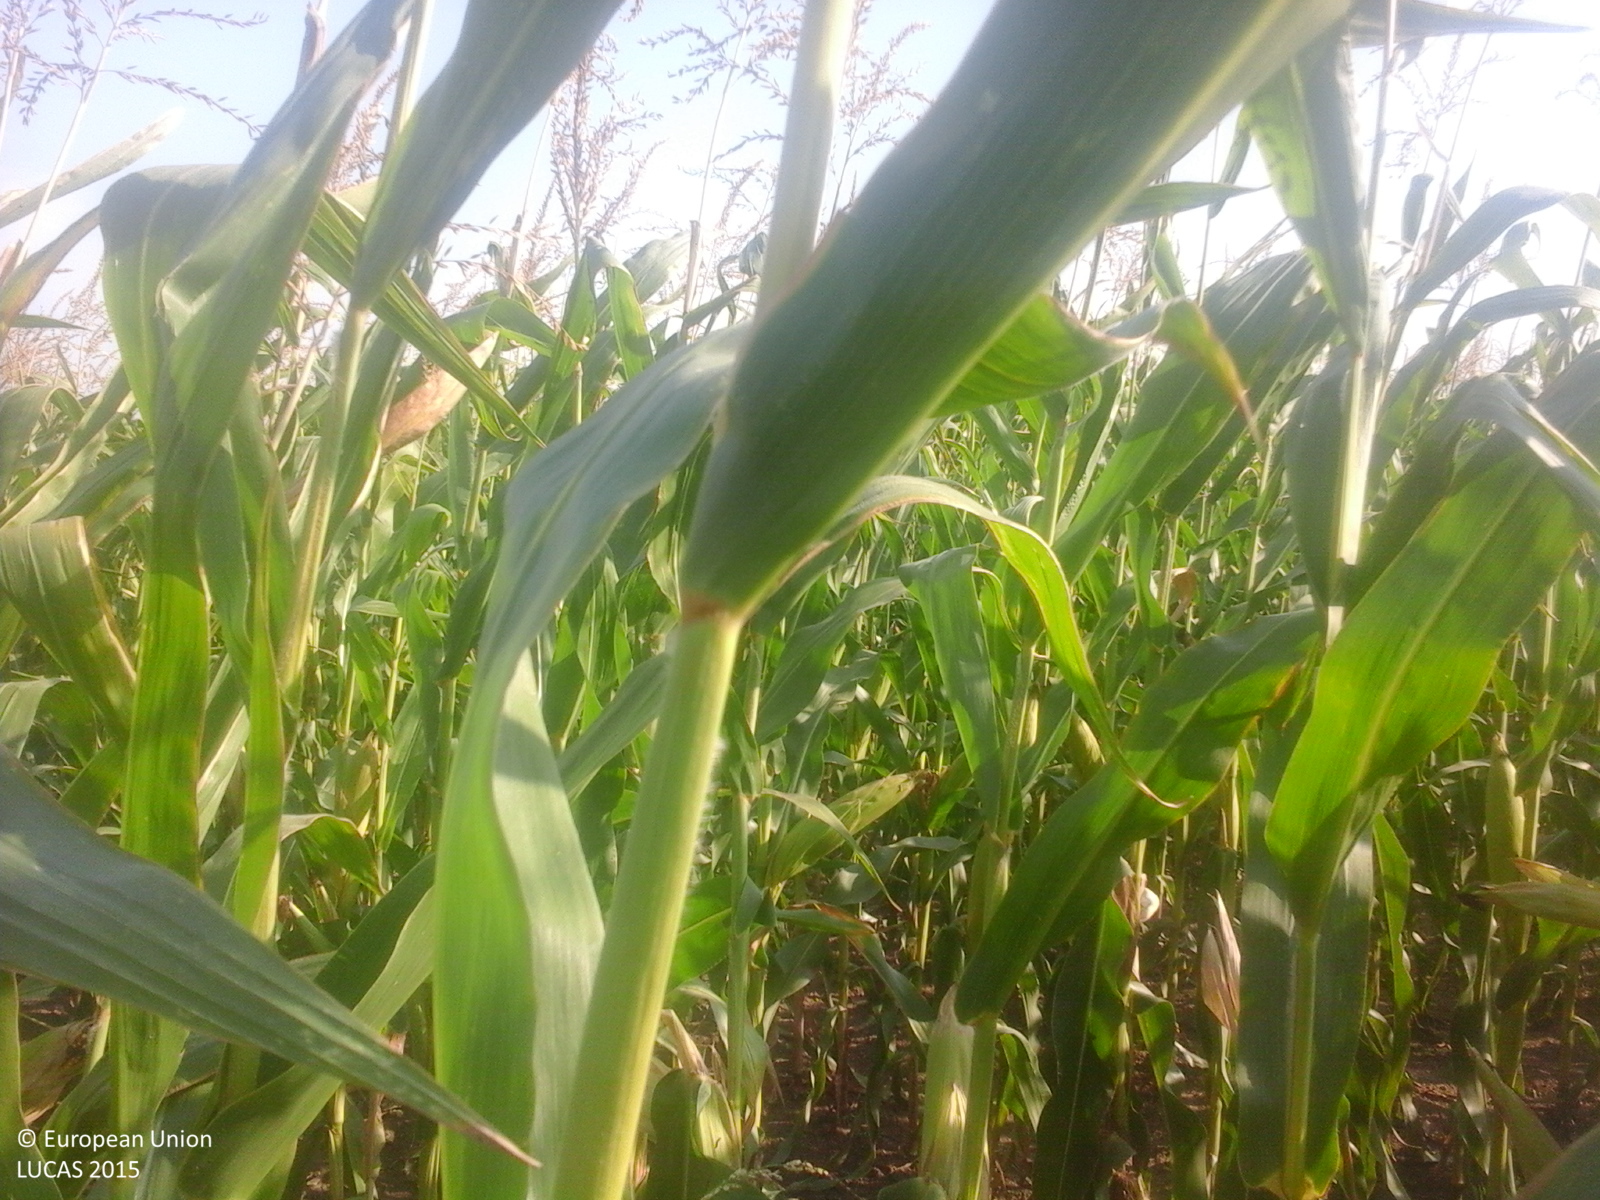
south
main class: Cropland
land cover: Maize
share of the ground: > 75 %
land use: Agriculture (excluding fallow land and kitchen gardens)
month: August
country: RO
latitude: 44.0233
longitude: 28.2626
